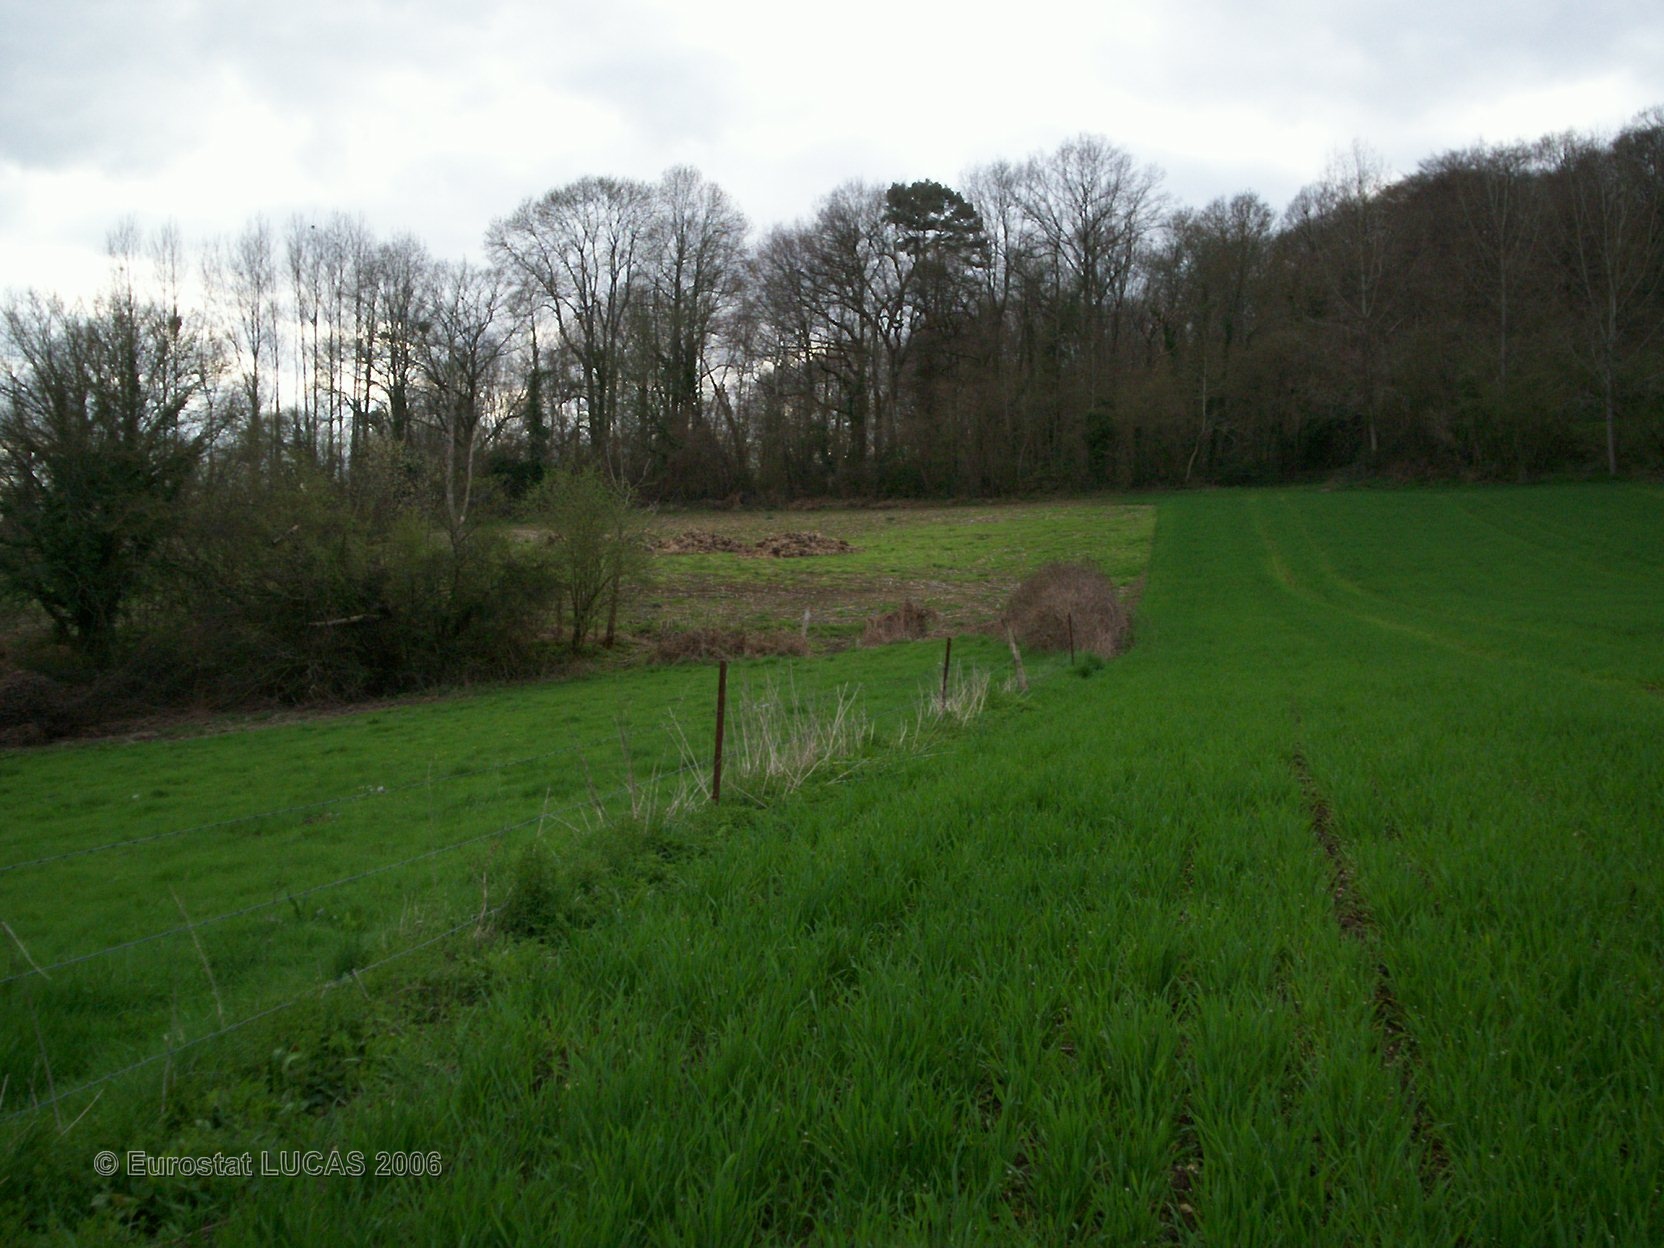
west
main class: Cropland
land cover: Common wheat
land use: Agriculture (excluding fallow land and kitchen gardens)
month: April
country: FR
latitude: 48.8811
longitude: 0.0840
